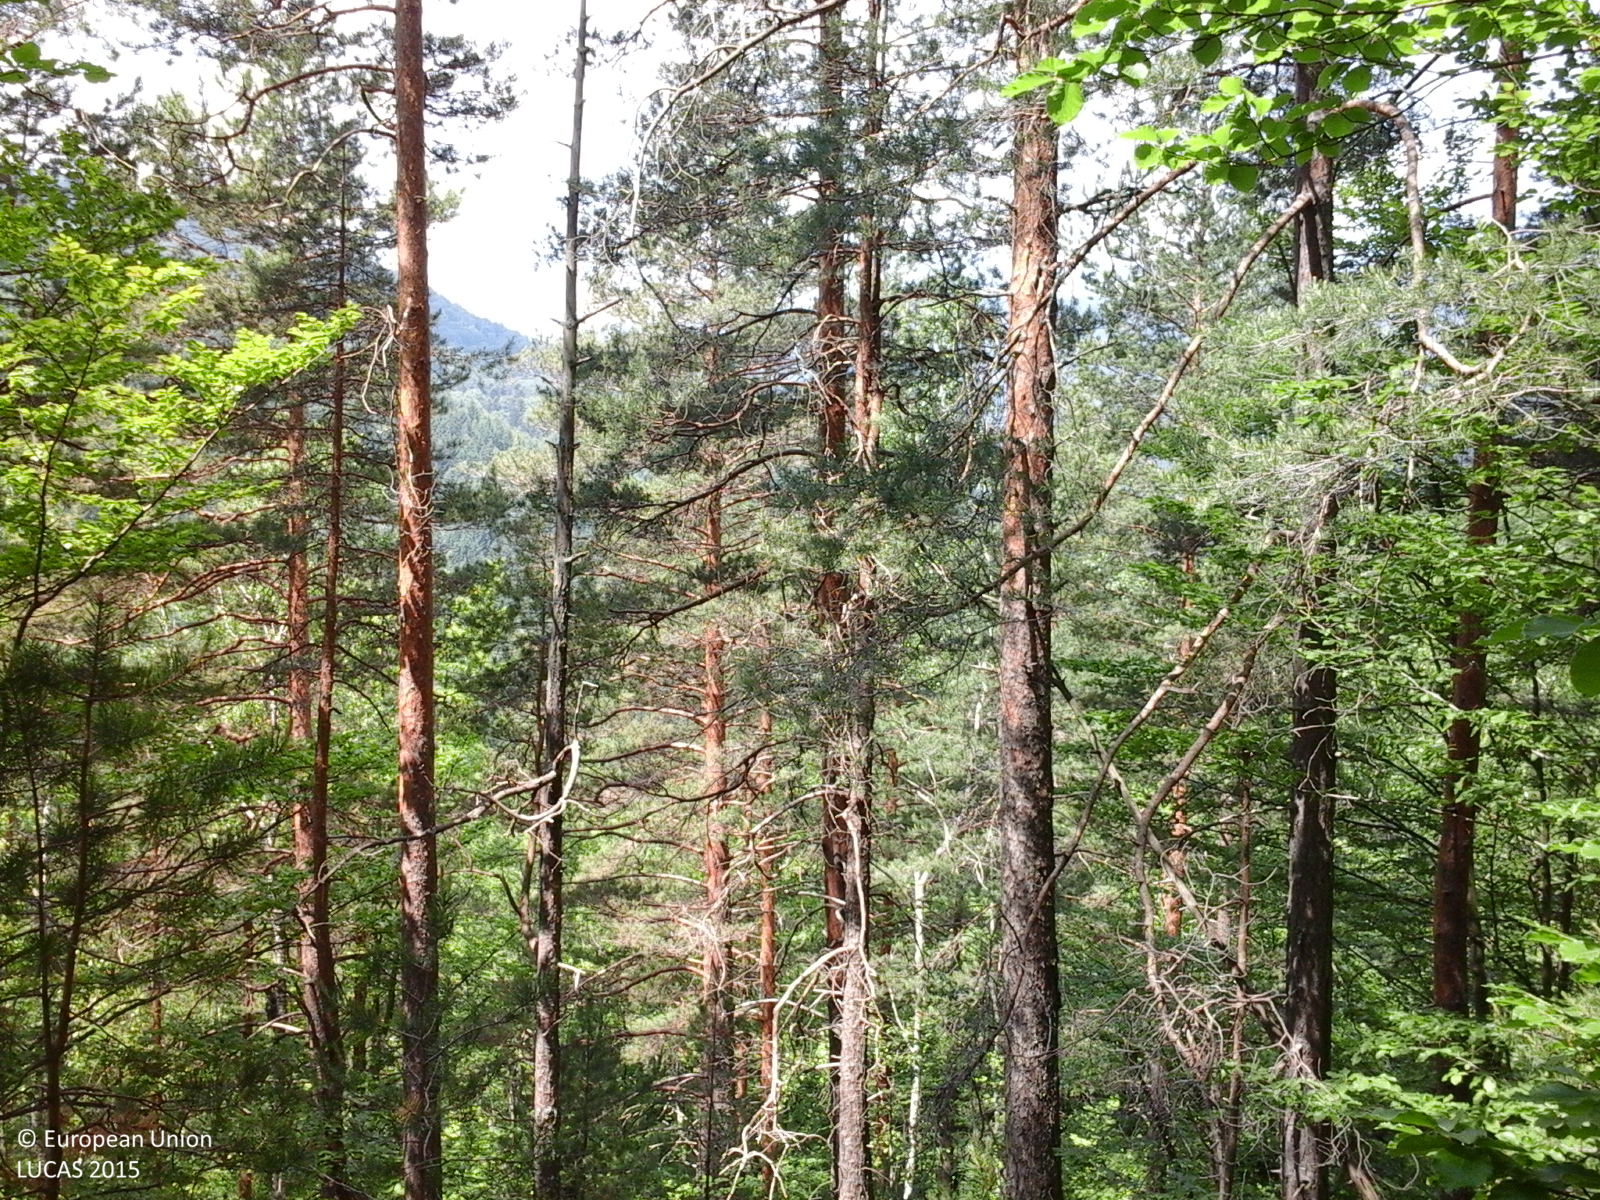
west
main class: Woodland
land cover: Pine dominated mixed woodland
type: alpine coniferous forest
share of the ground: > 75 %
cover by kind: coniferous forest trees 75 %, broadleaved forest trees 25 %
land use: Forestry
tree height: > 5 m
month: June
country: RO
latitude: 46.2620
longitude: 26.4386
